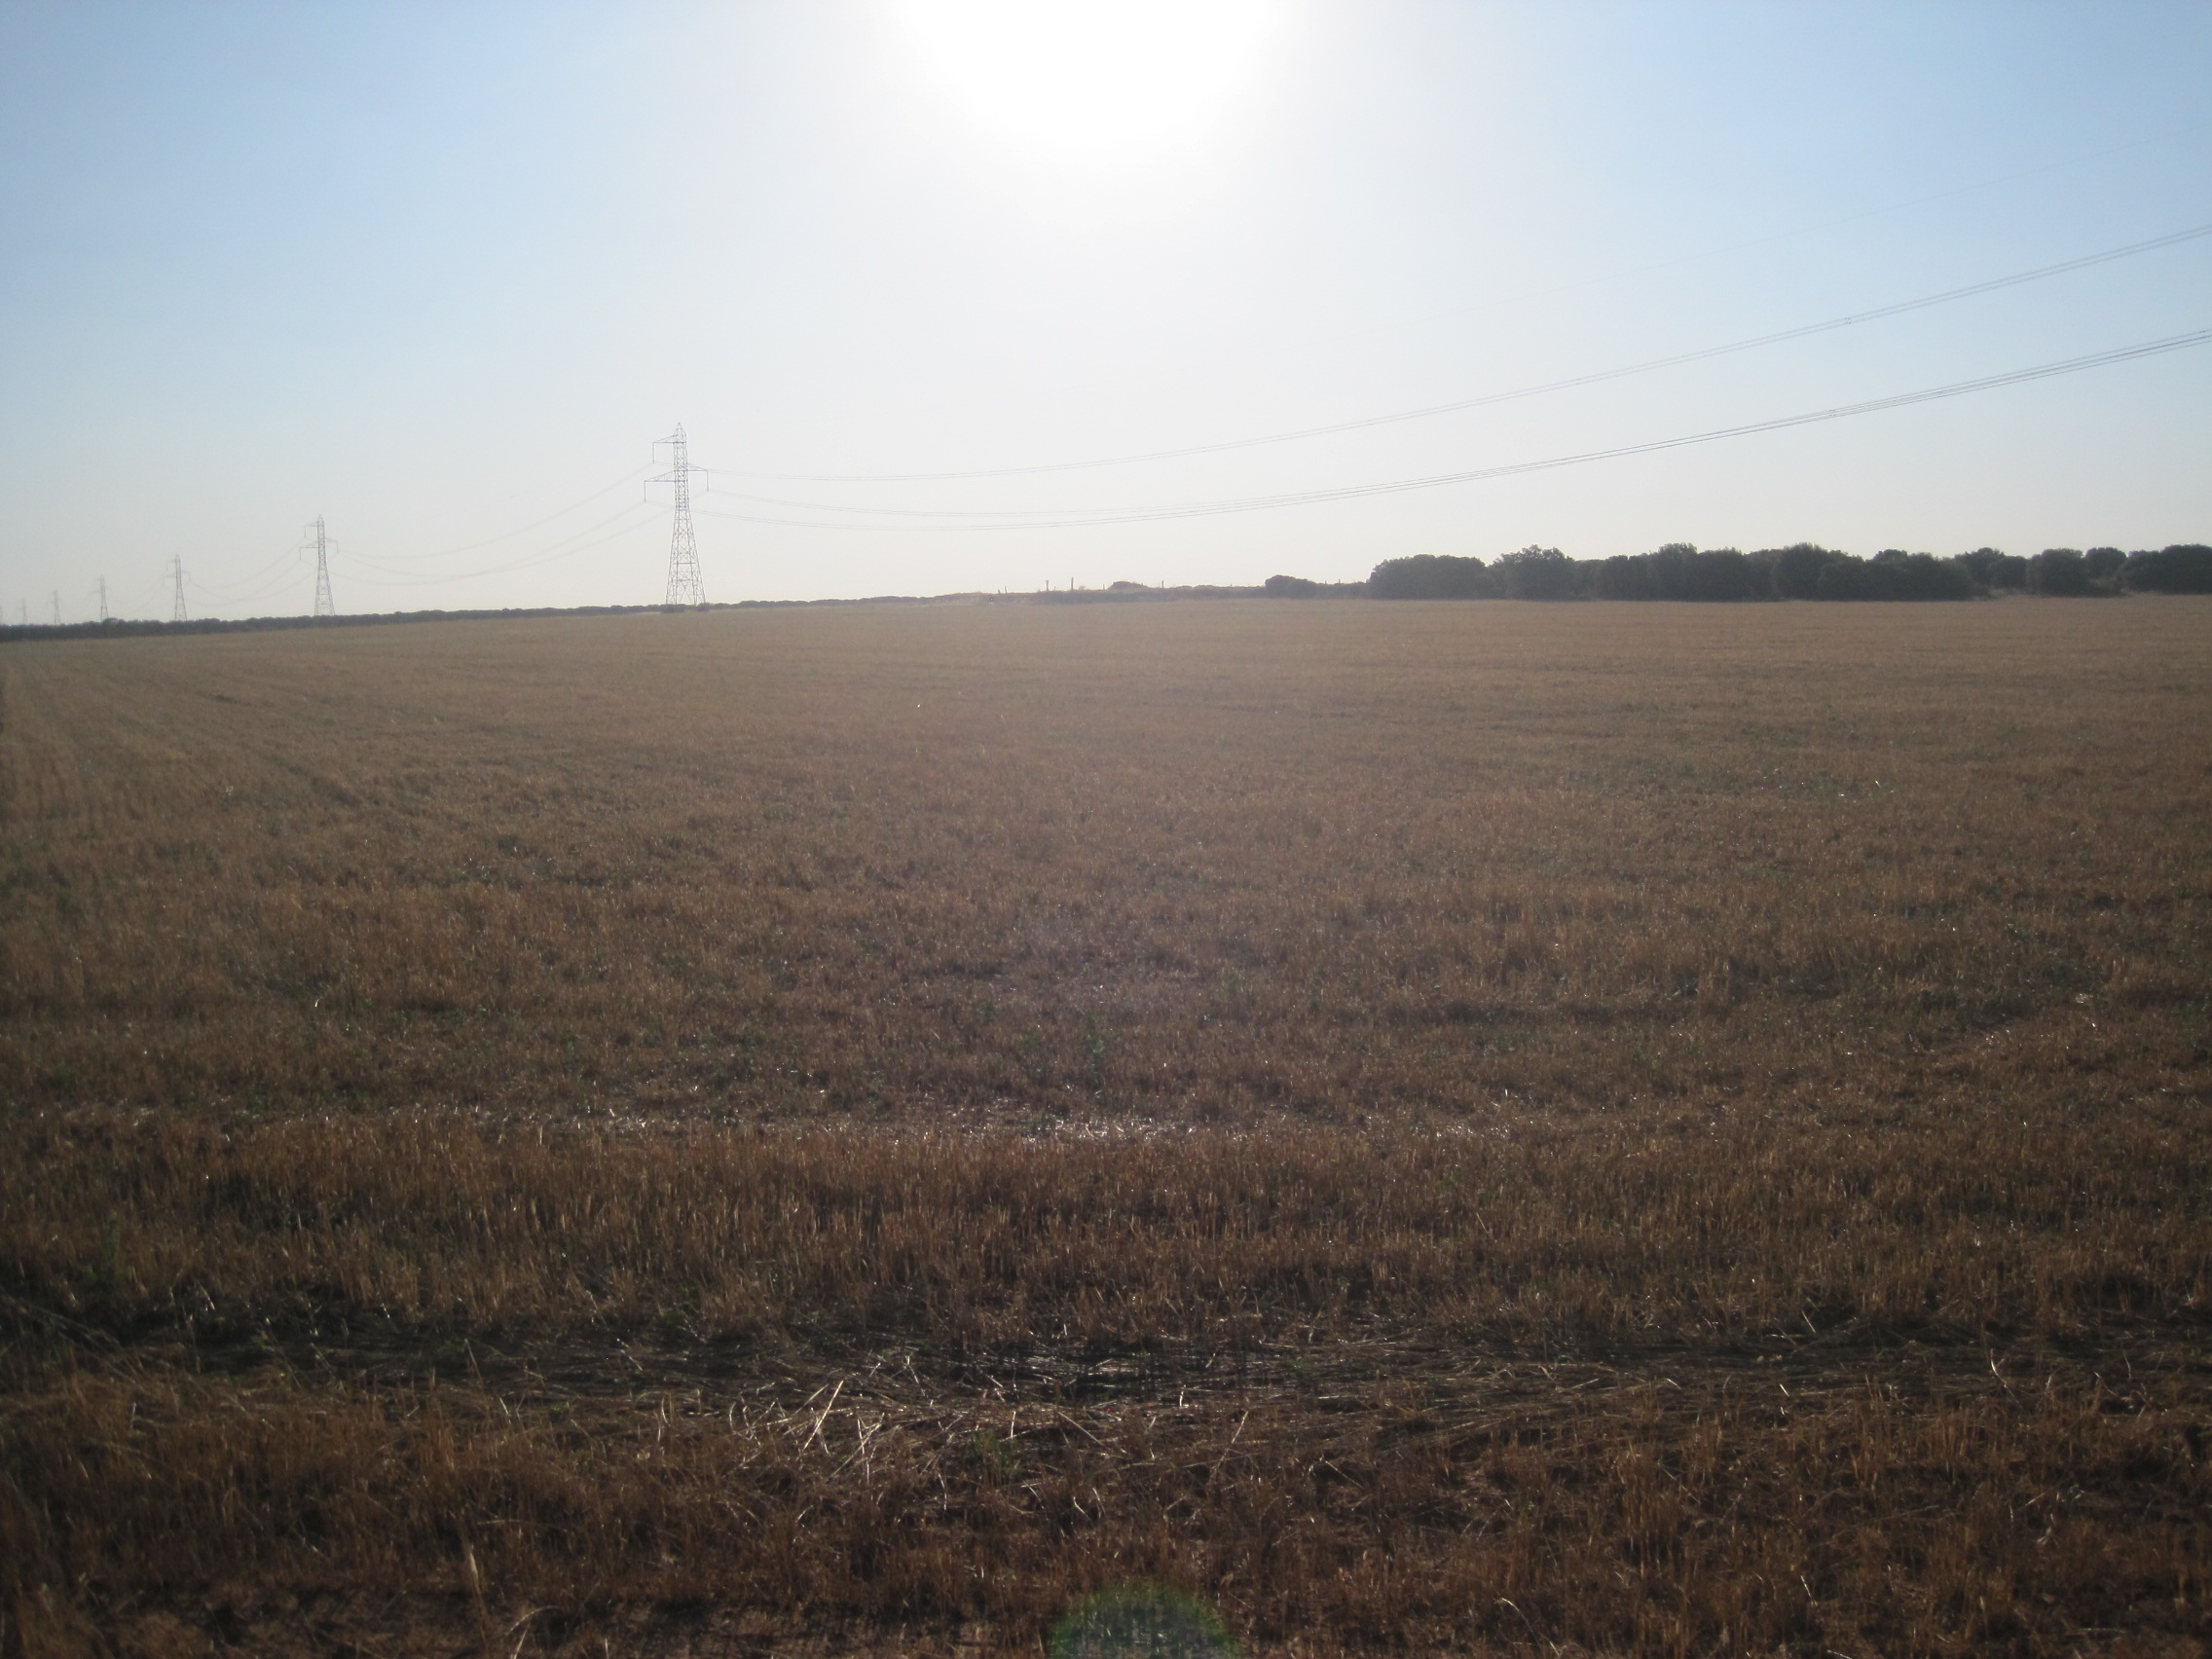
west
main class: Grassland
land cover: Grassland without tree/shrub cover
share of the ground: > 75 %
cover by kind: herbaceous plants 100 %
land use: Semi-natural and natural areas not in use
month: July
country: ES
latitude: 41.7107
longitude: -5.1365
